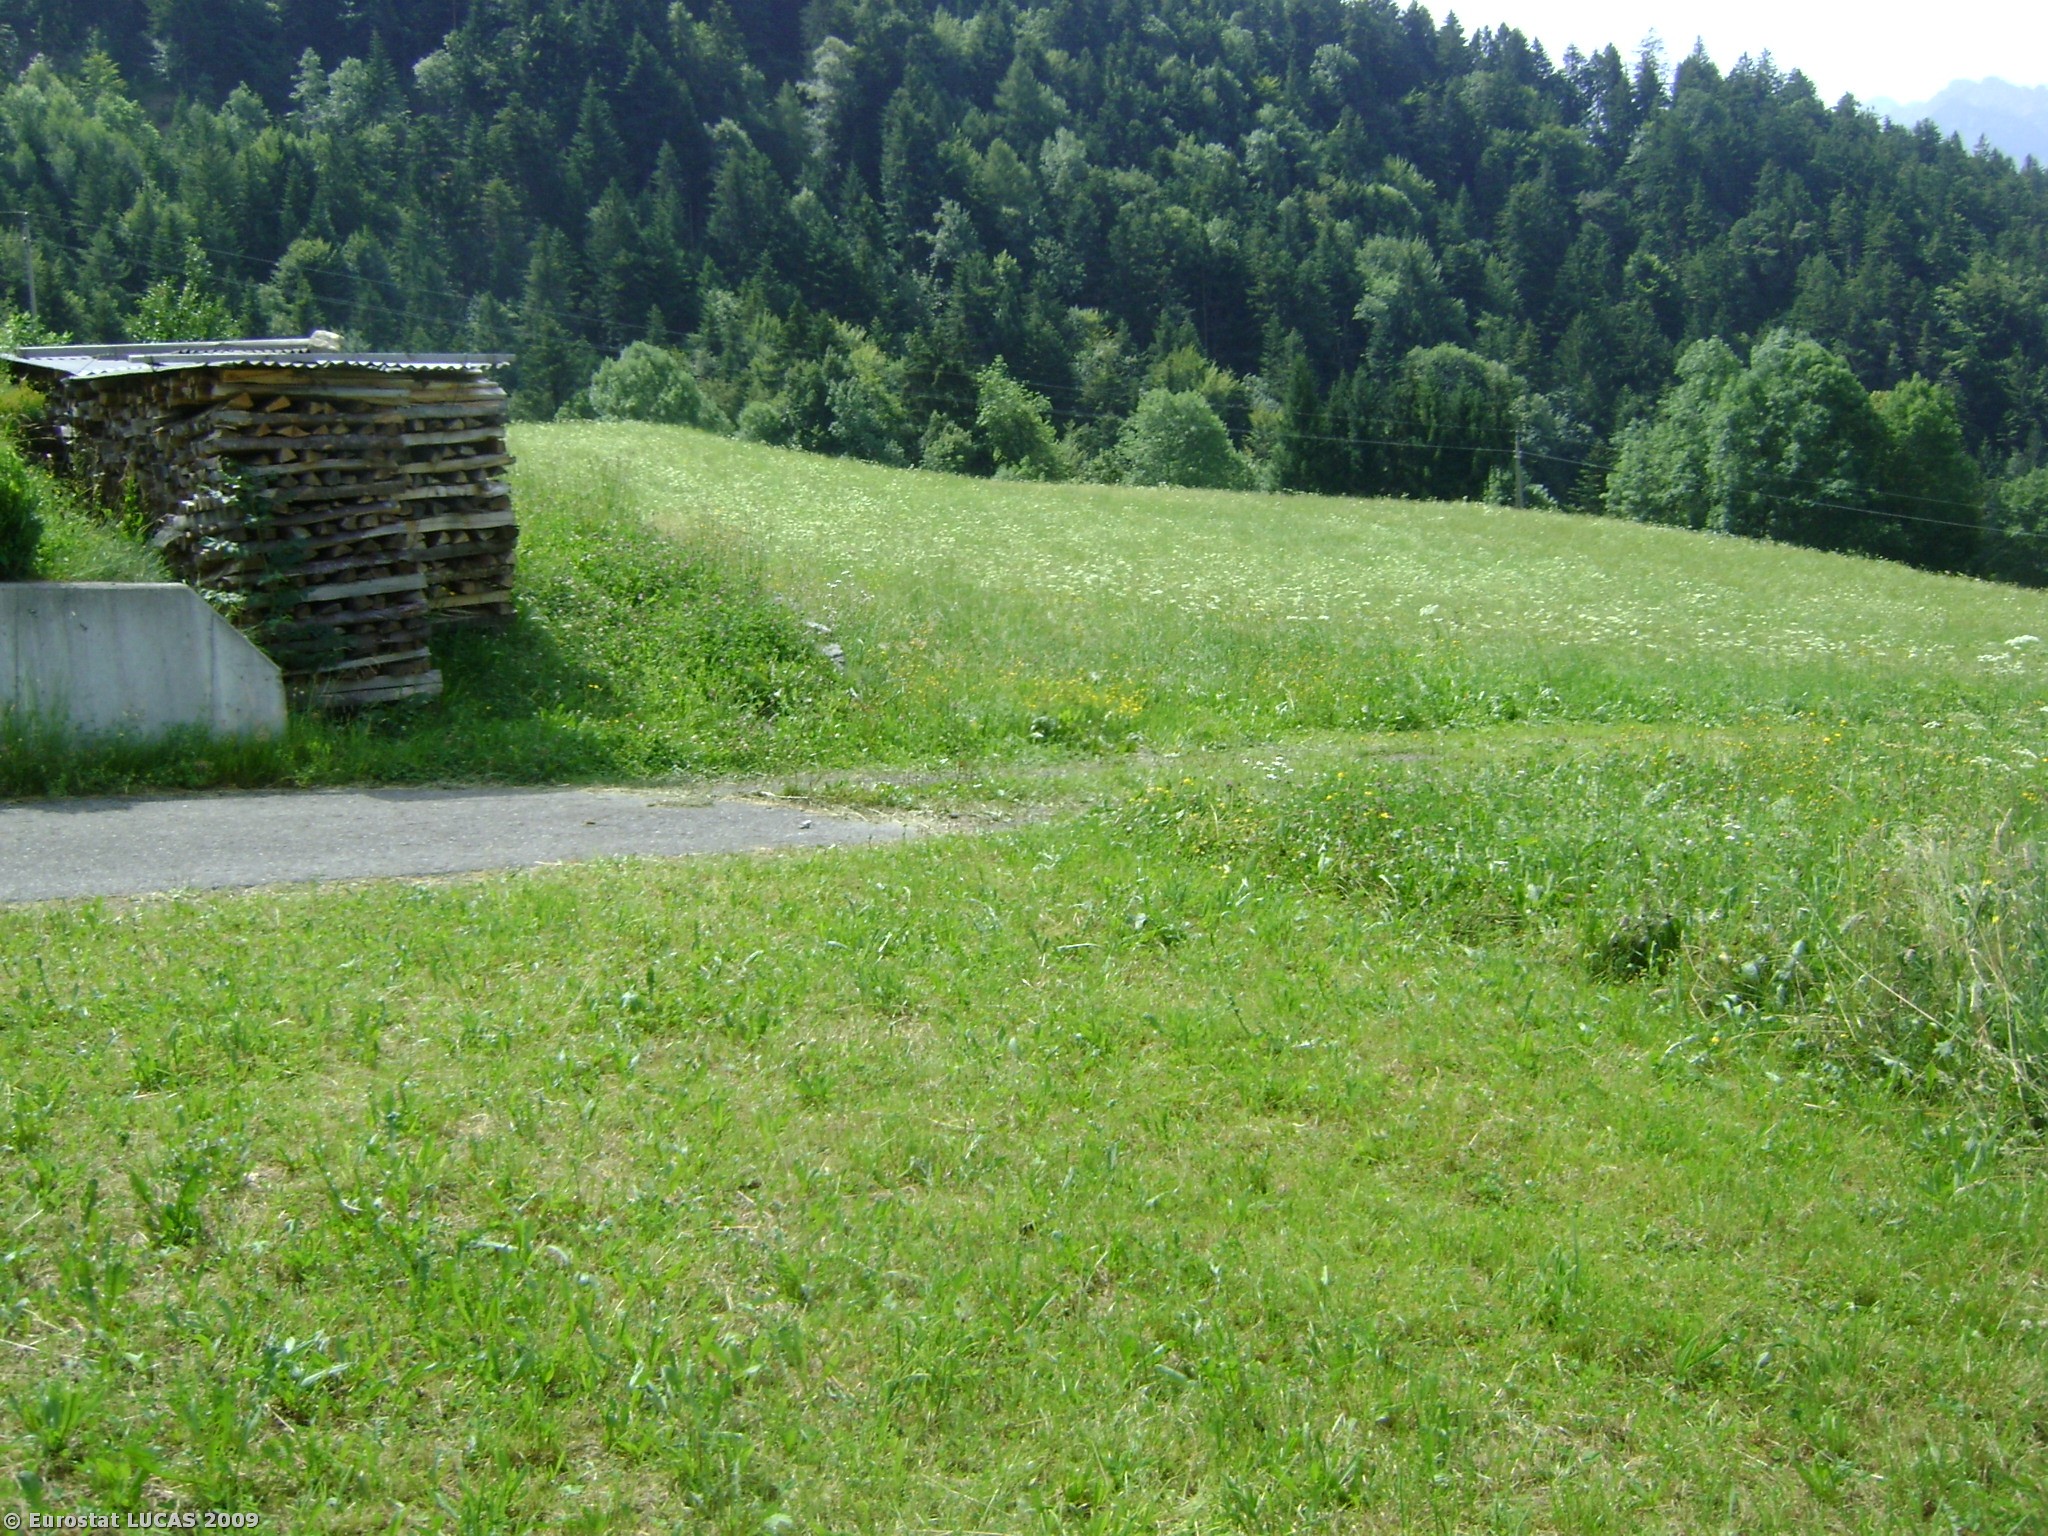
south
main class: Grassland
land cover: Grassland without tree/shrub cover
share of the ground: > 75 %
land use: Agriculture (excluding fallow land and kitchen gardens)
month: July
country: AT
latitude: 47.2511
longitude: 9.6700
